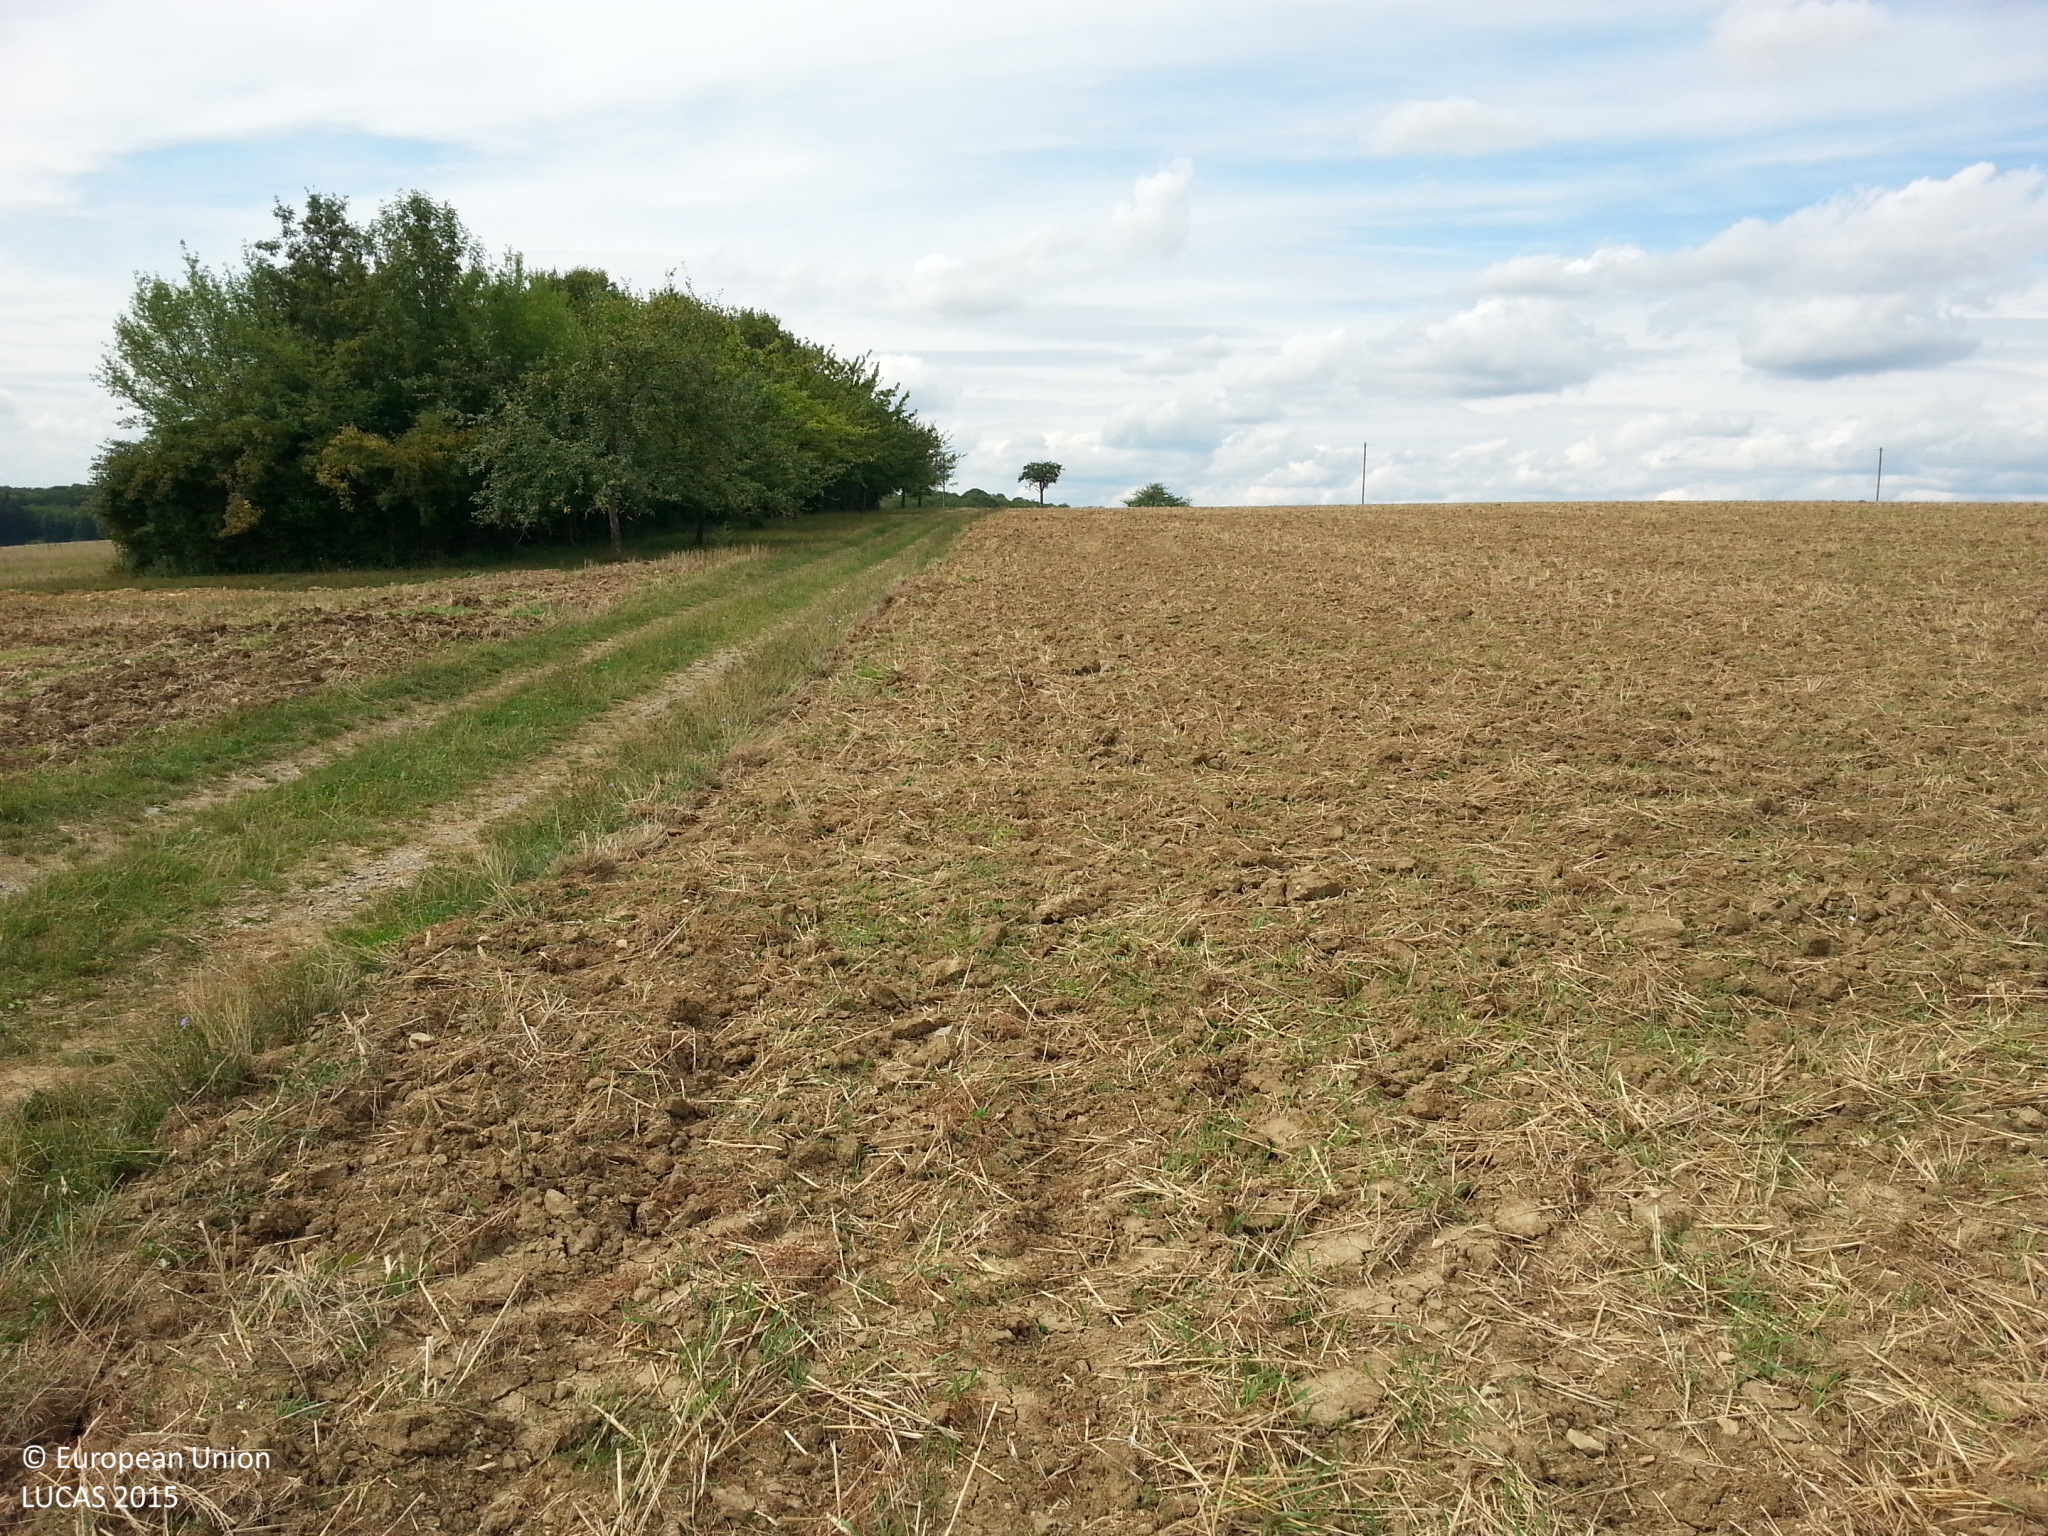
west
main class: Cropland
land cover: Common wheat
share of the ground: < 10 %
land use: Agriculture (excluding fallow land and kitchen gardens)
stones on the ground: < 10 %
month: September
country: DE
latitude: 49.4462
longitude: 9.6002
